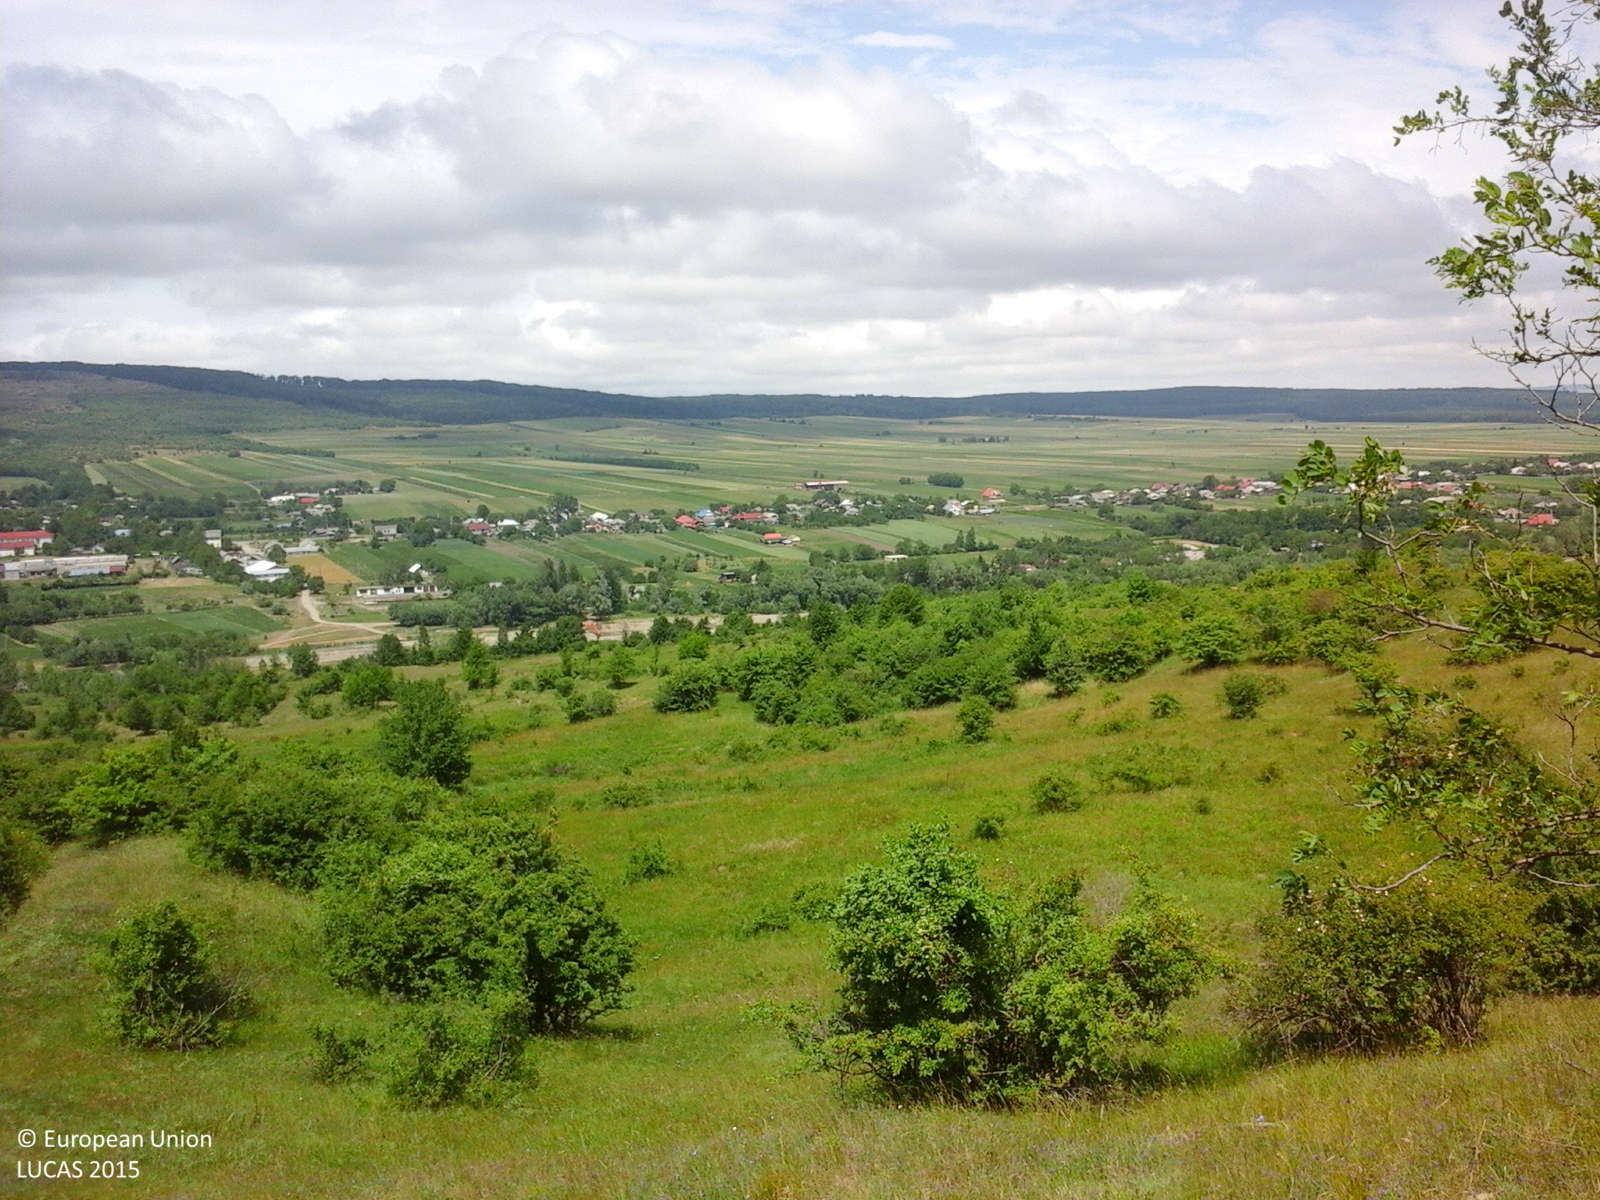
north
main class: Grassland
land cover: Grassland with sparse tree/shrub cover
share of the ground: > 75 %
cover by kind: herbaceous plants 85 %, shrubs 10 %, broadleaved forest trees 5 %
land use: Agriculture (excluding fallow land and kitchen gardens)
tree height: > 5 m
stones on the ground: < 10 %
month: June
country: RO
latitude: 47.1594
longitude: 26.4546
